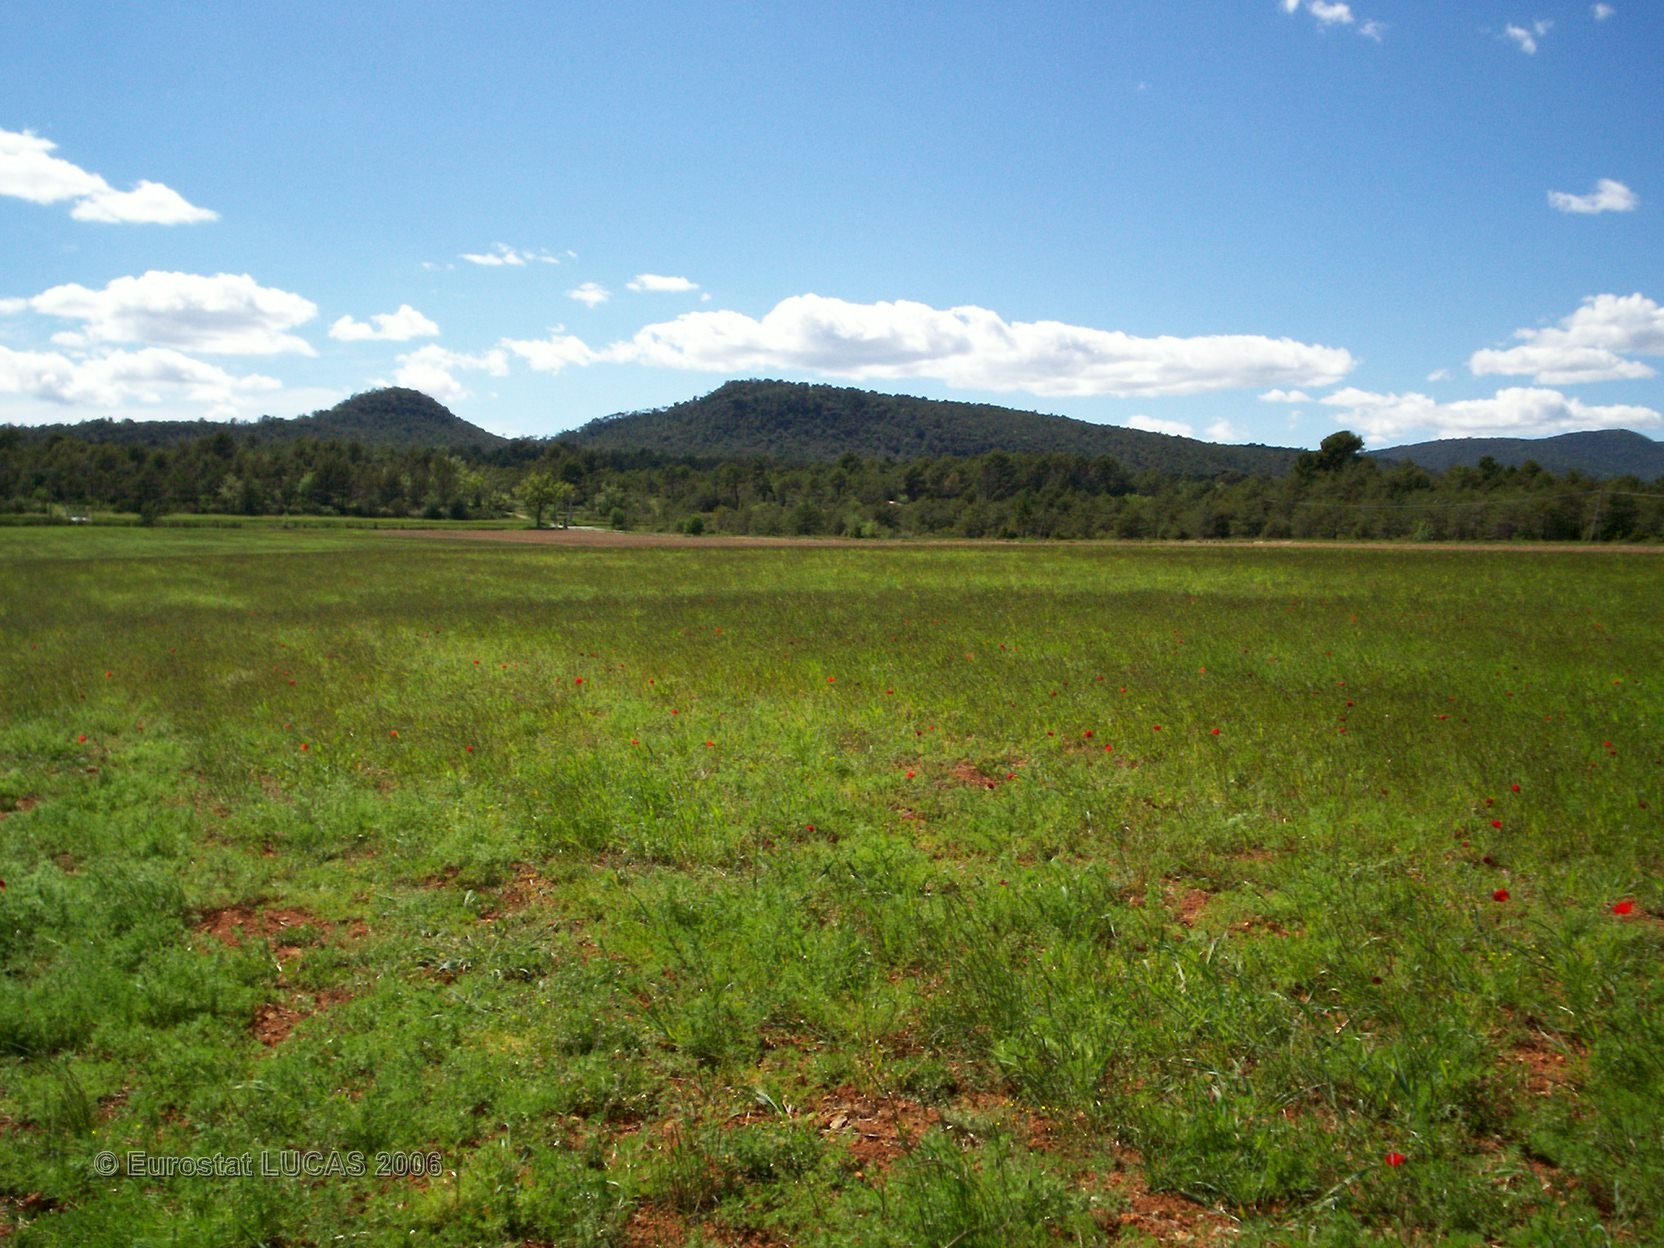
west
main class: Grassland
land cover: Grassland without tree/shrub cover
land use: Agriculture (excluding fallow land and kitchen gardens)
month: May
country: FR
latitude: 43.6183
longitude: 6.3529
